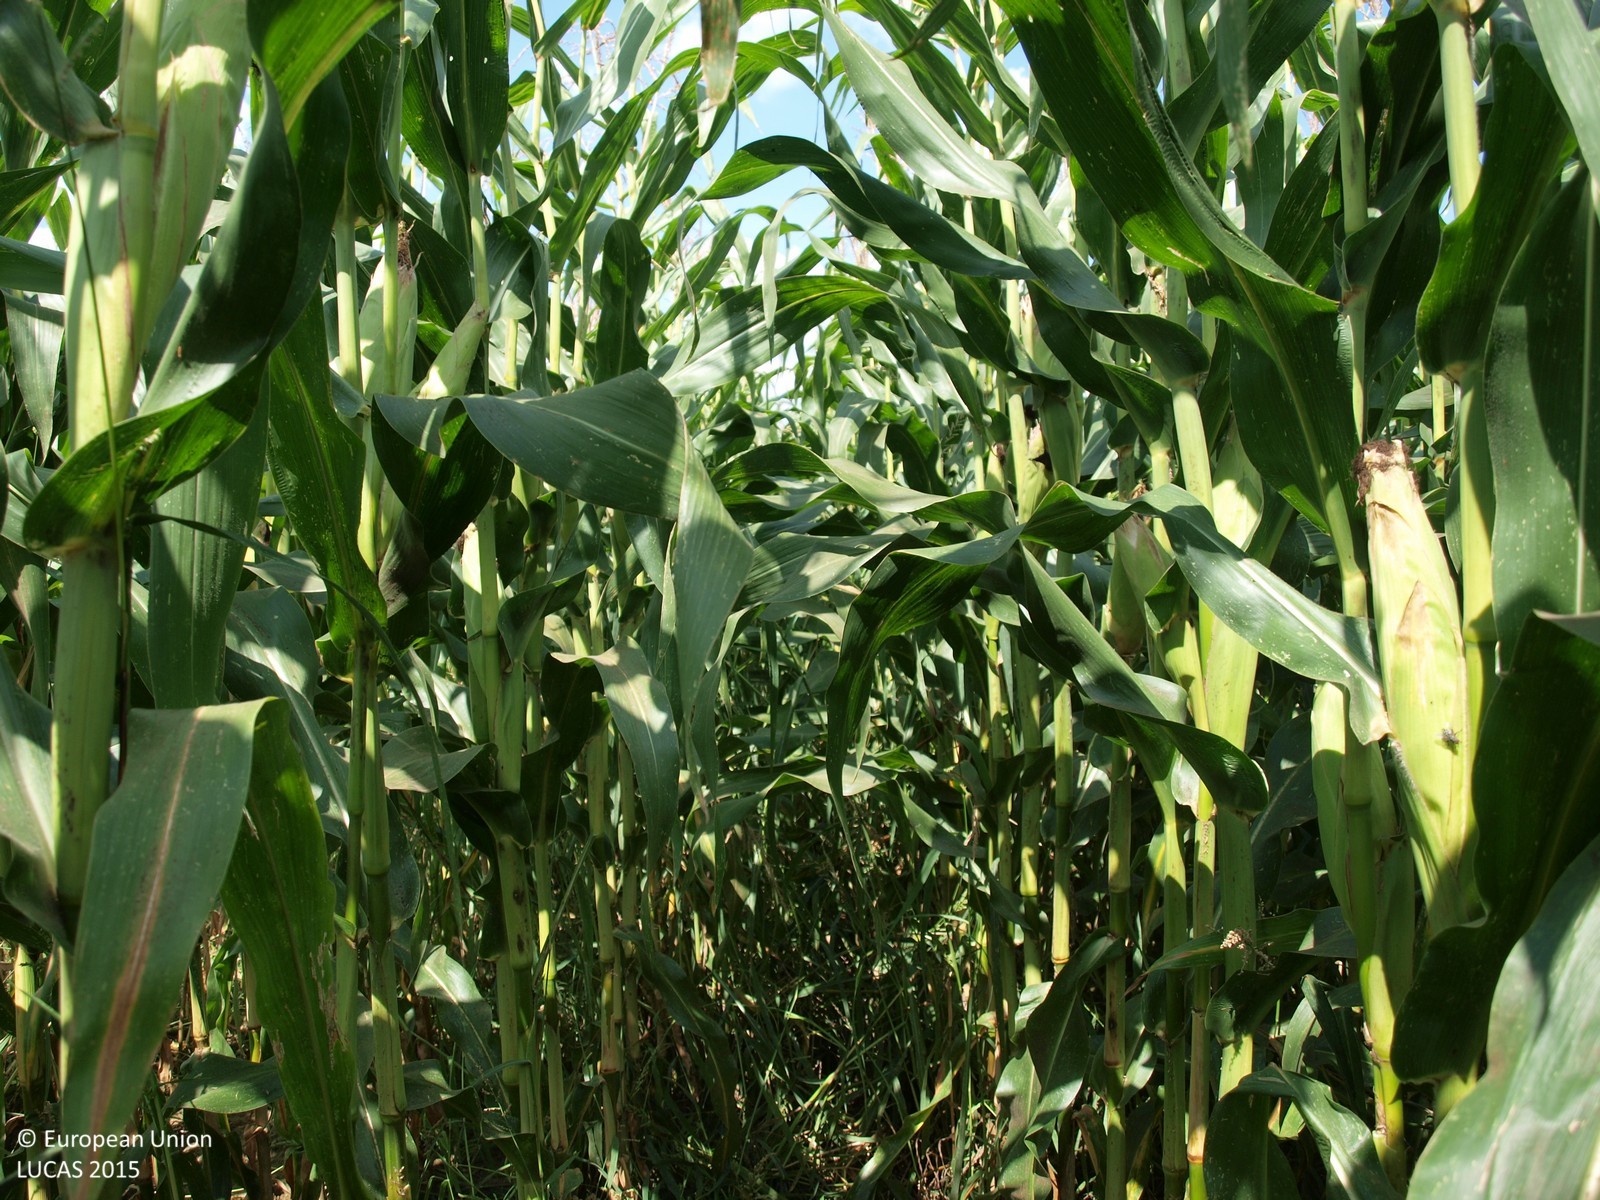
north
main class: Cropland
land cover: Maize
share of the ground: > 75 %
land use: Agriculture (excluding fallow land and kitchen gardens)
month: August
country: HR
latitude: 46.0793
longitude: 16.5301
